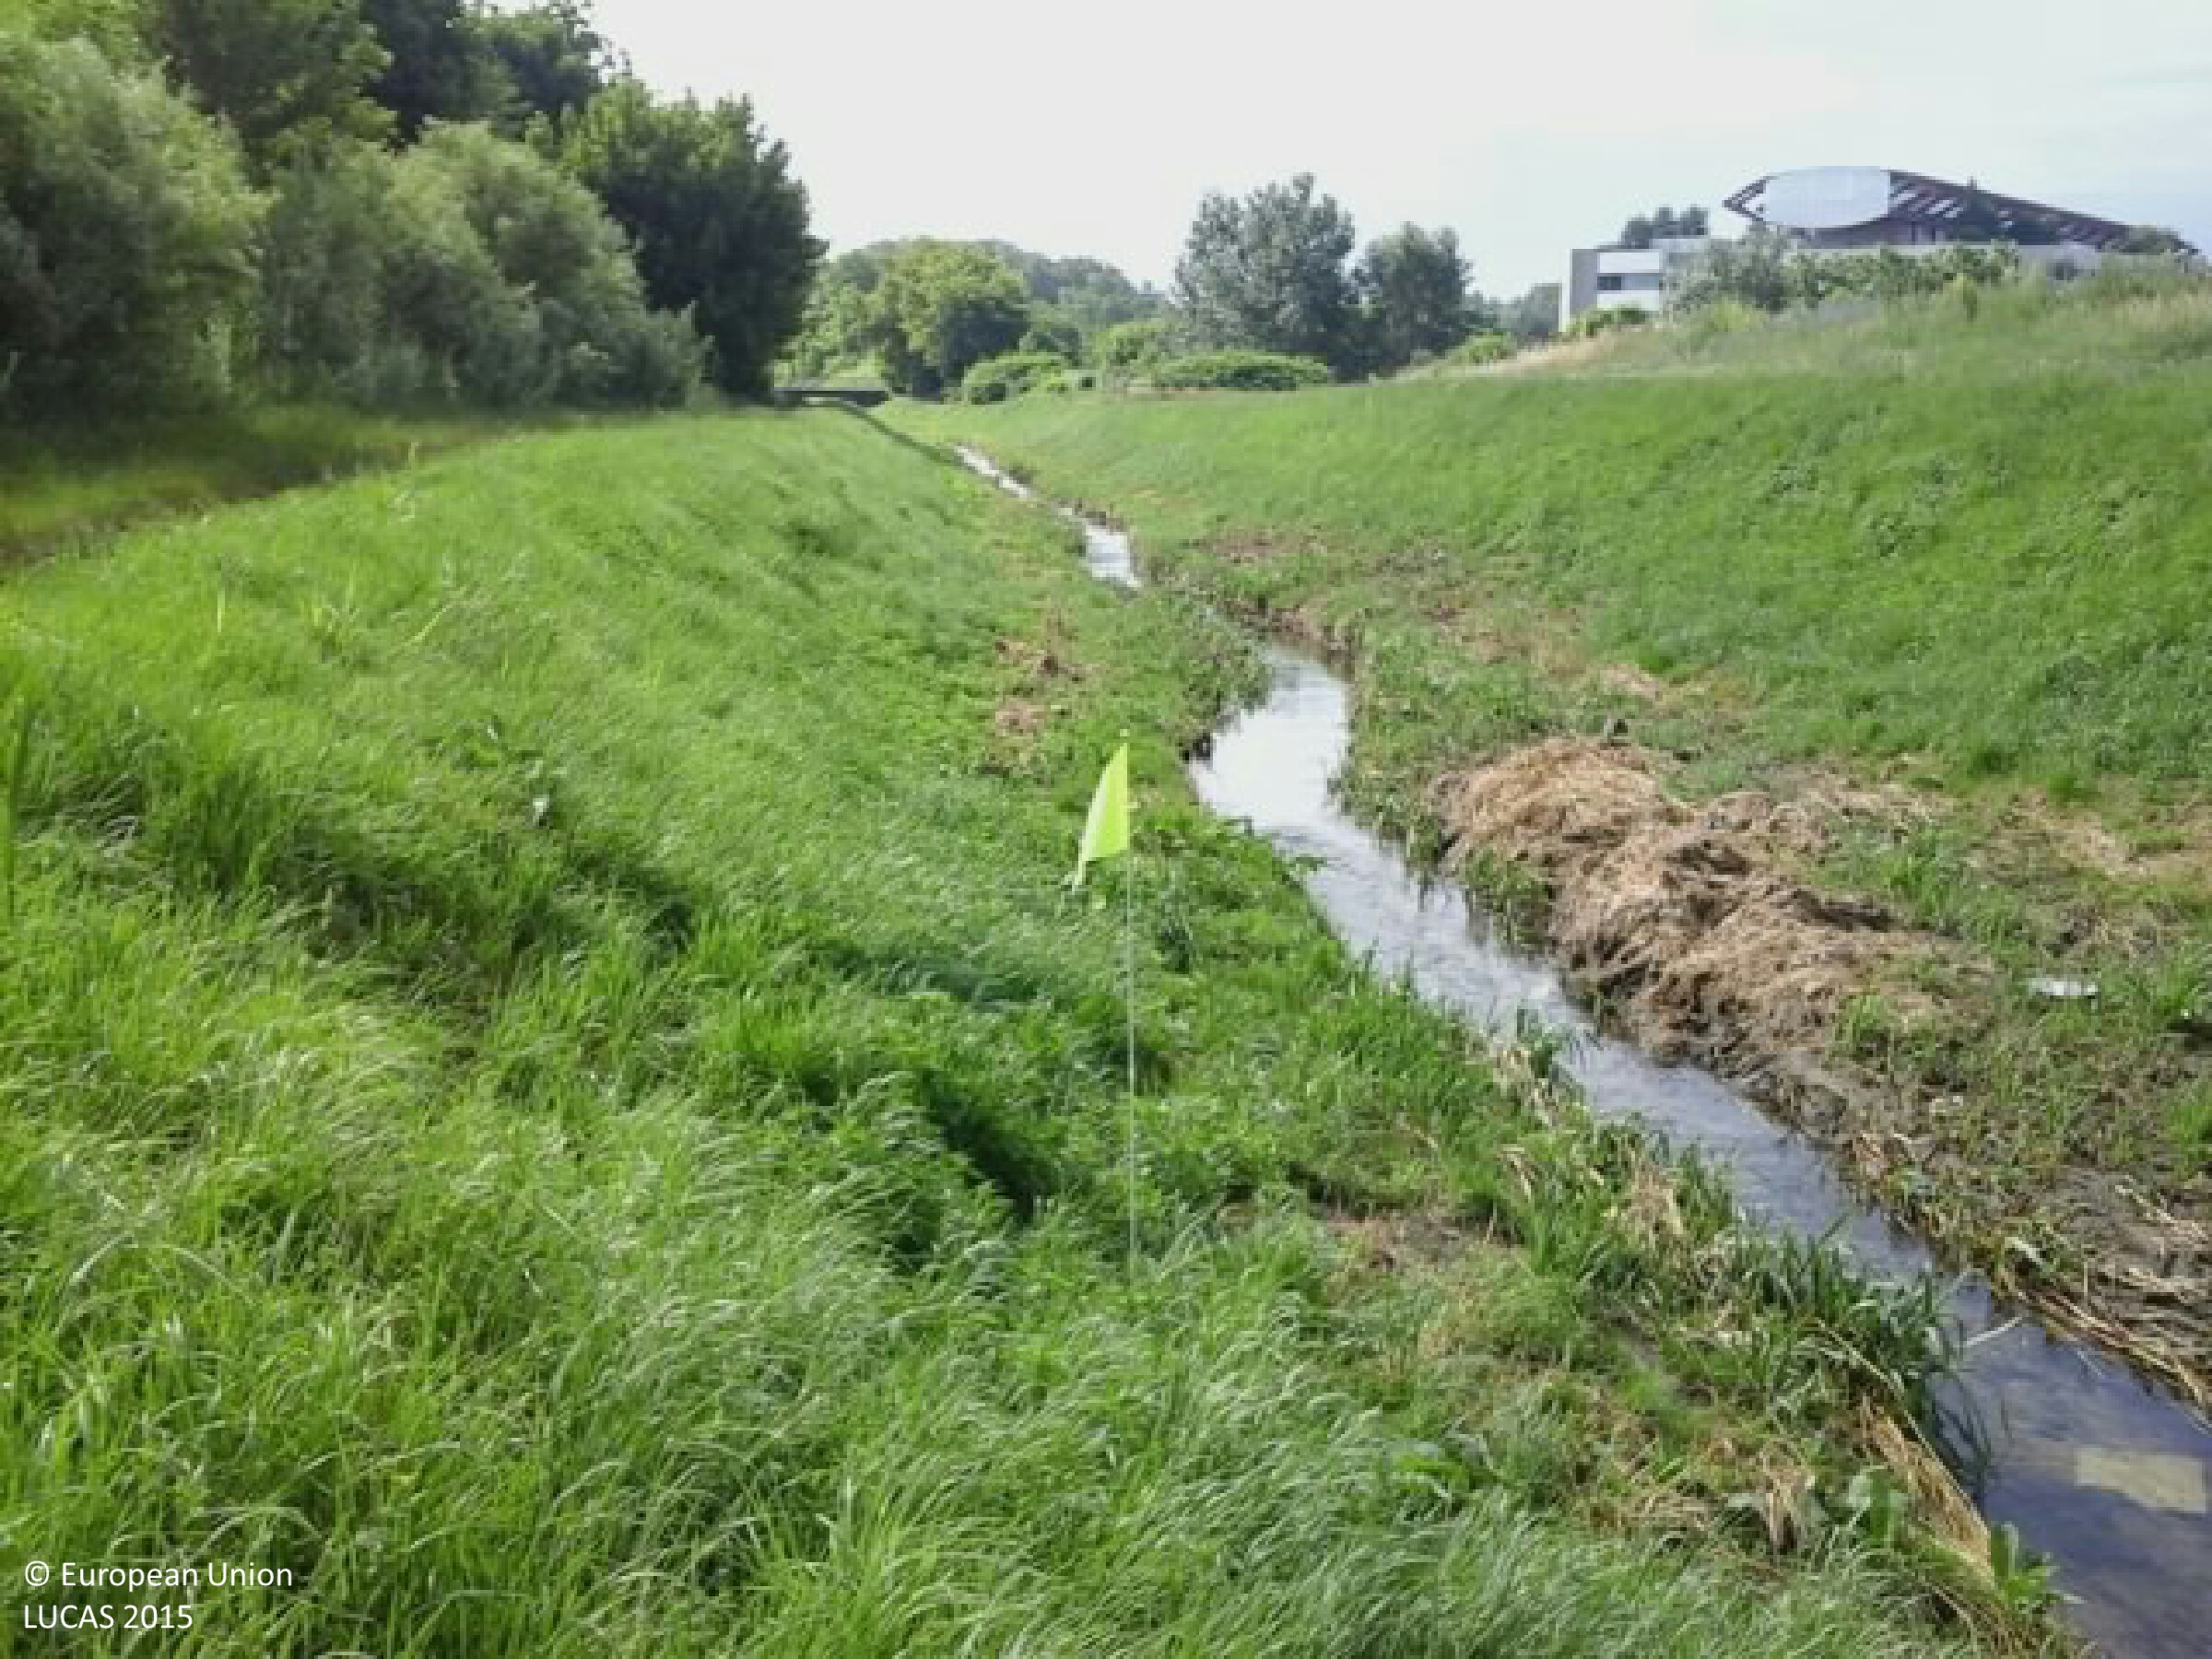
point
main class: Grassland
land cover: Grassland without tree/shrub cover
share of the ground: > 75 %
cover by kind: herbaceous plants 100 %
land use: Semi-natural and natural areas not in use
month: June
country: HU
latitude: 47.5528
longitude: 19.1480
